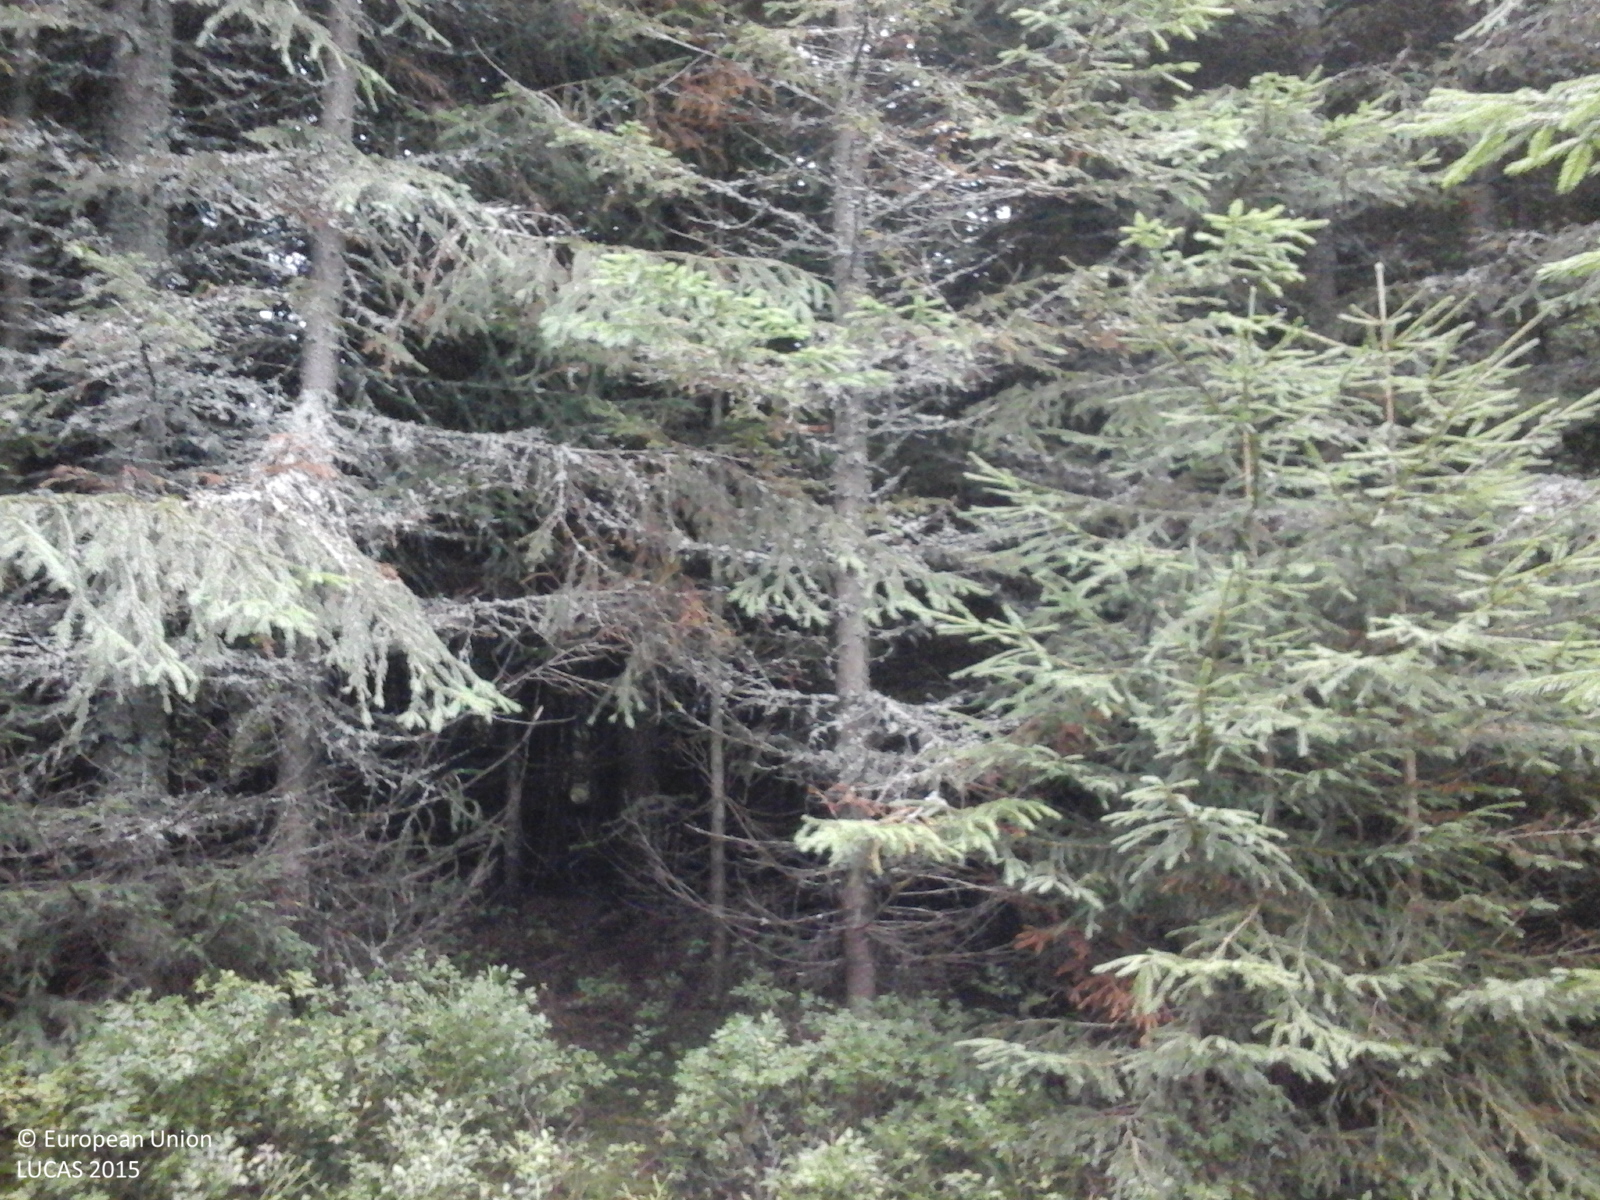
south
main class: Woodland
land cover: Spruce dominated coniferous woodland
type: alpine coniferous forest
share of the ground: > 75 %
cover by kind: coniferous forest trees 100 %
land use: Forestry
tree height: > 5 m
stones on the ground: < 10 %
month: September
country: RO
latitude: 46.5469
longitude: 22.9303
